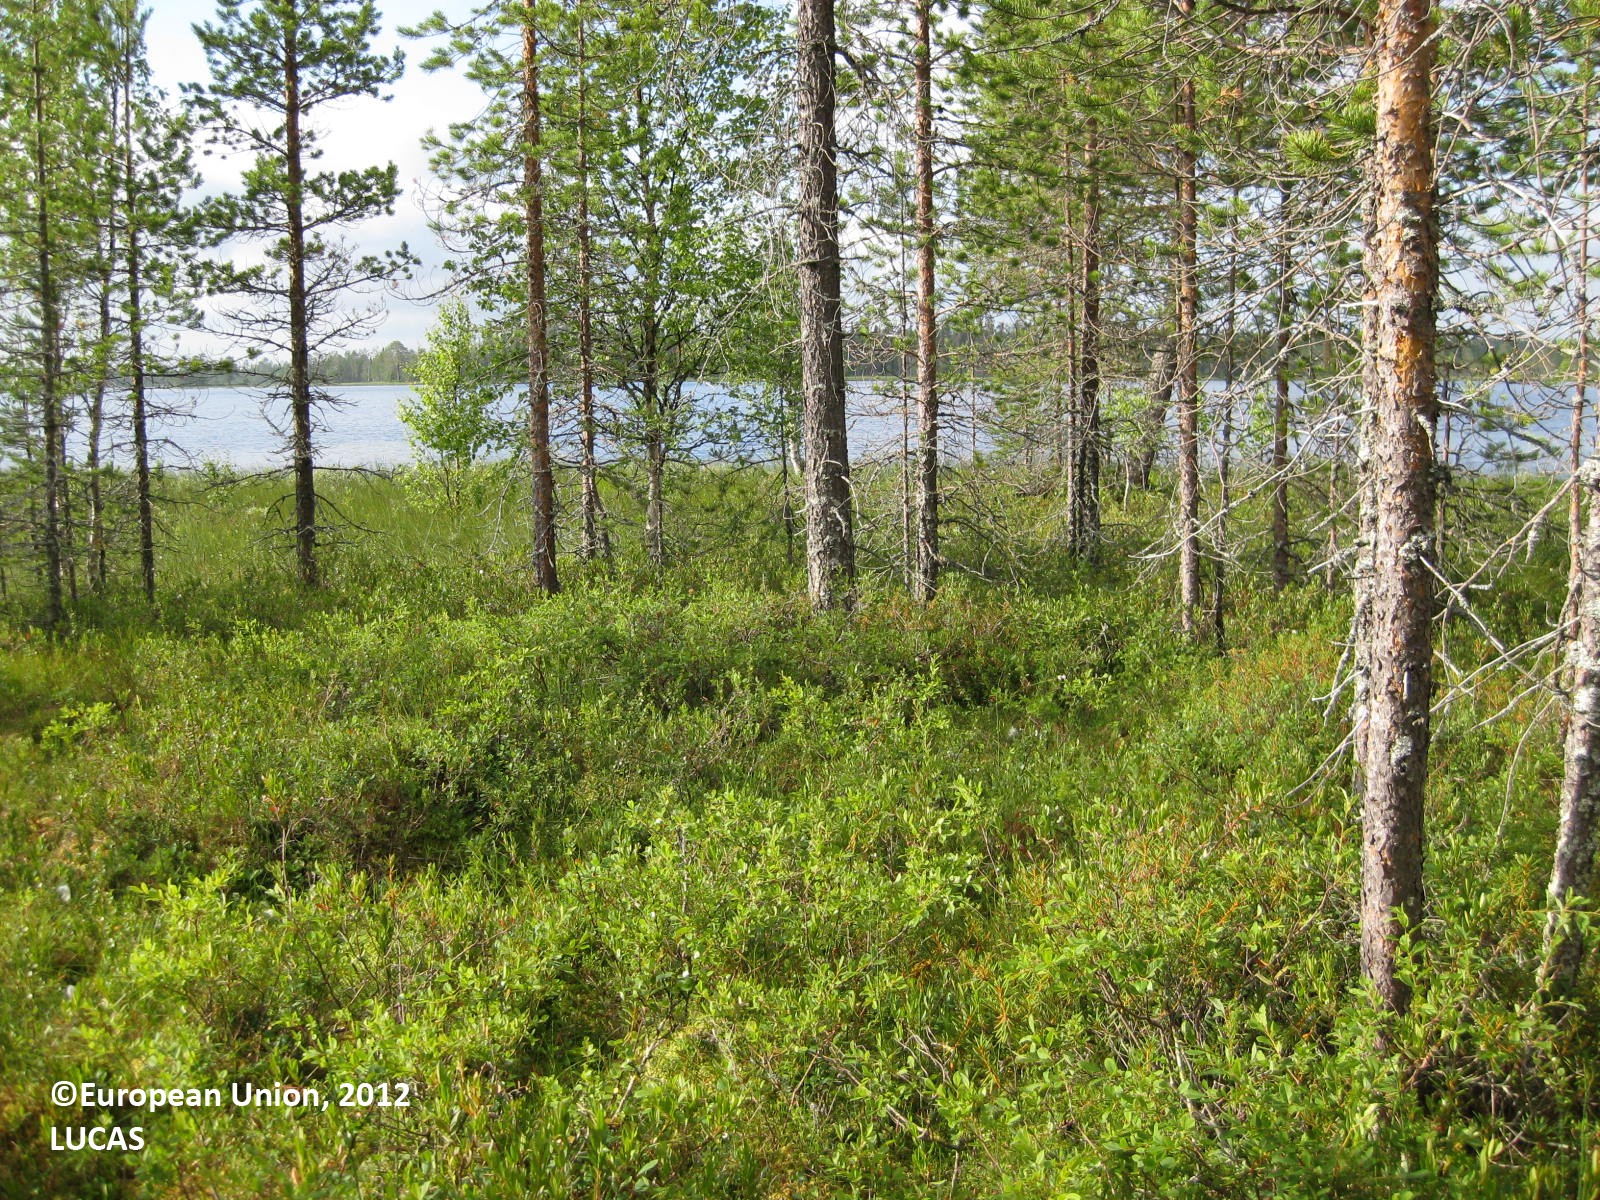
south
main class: Woodland
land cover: Pine dominated coniferous woodland
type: boreal forest
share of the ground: 50 - 75 %
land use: Forestry
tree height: > 5 m
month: July
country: FI
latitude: 65.7679
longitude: 28.6120
